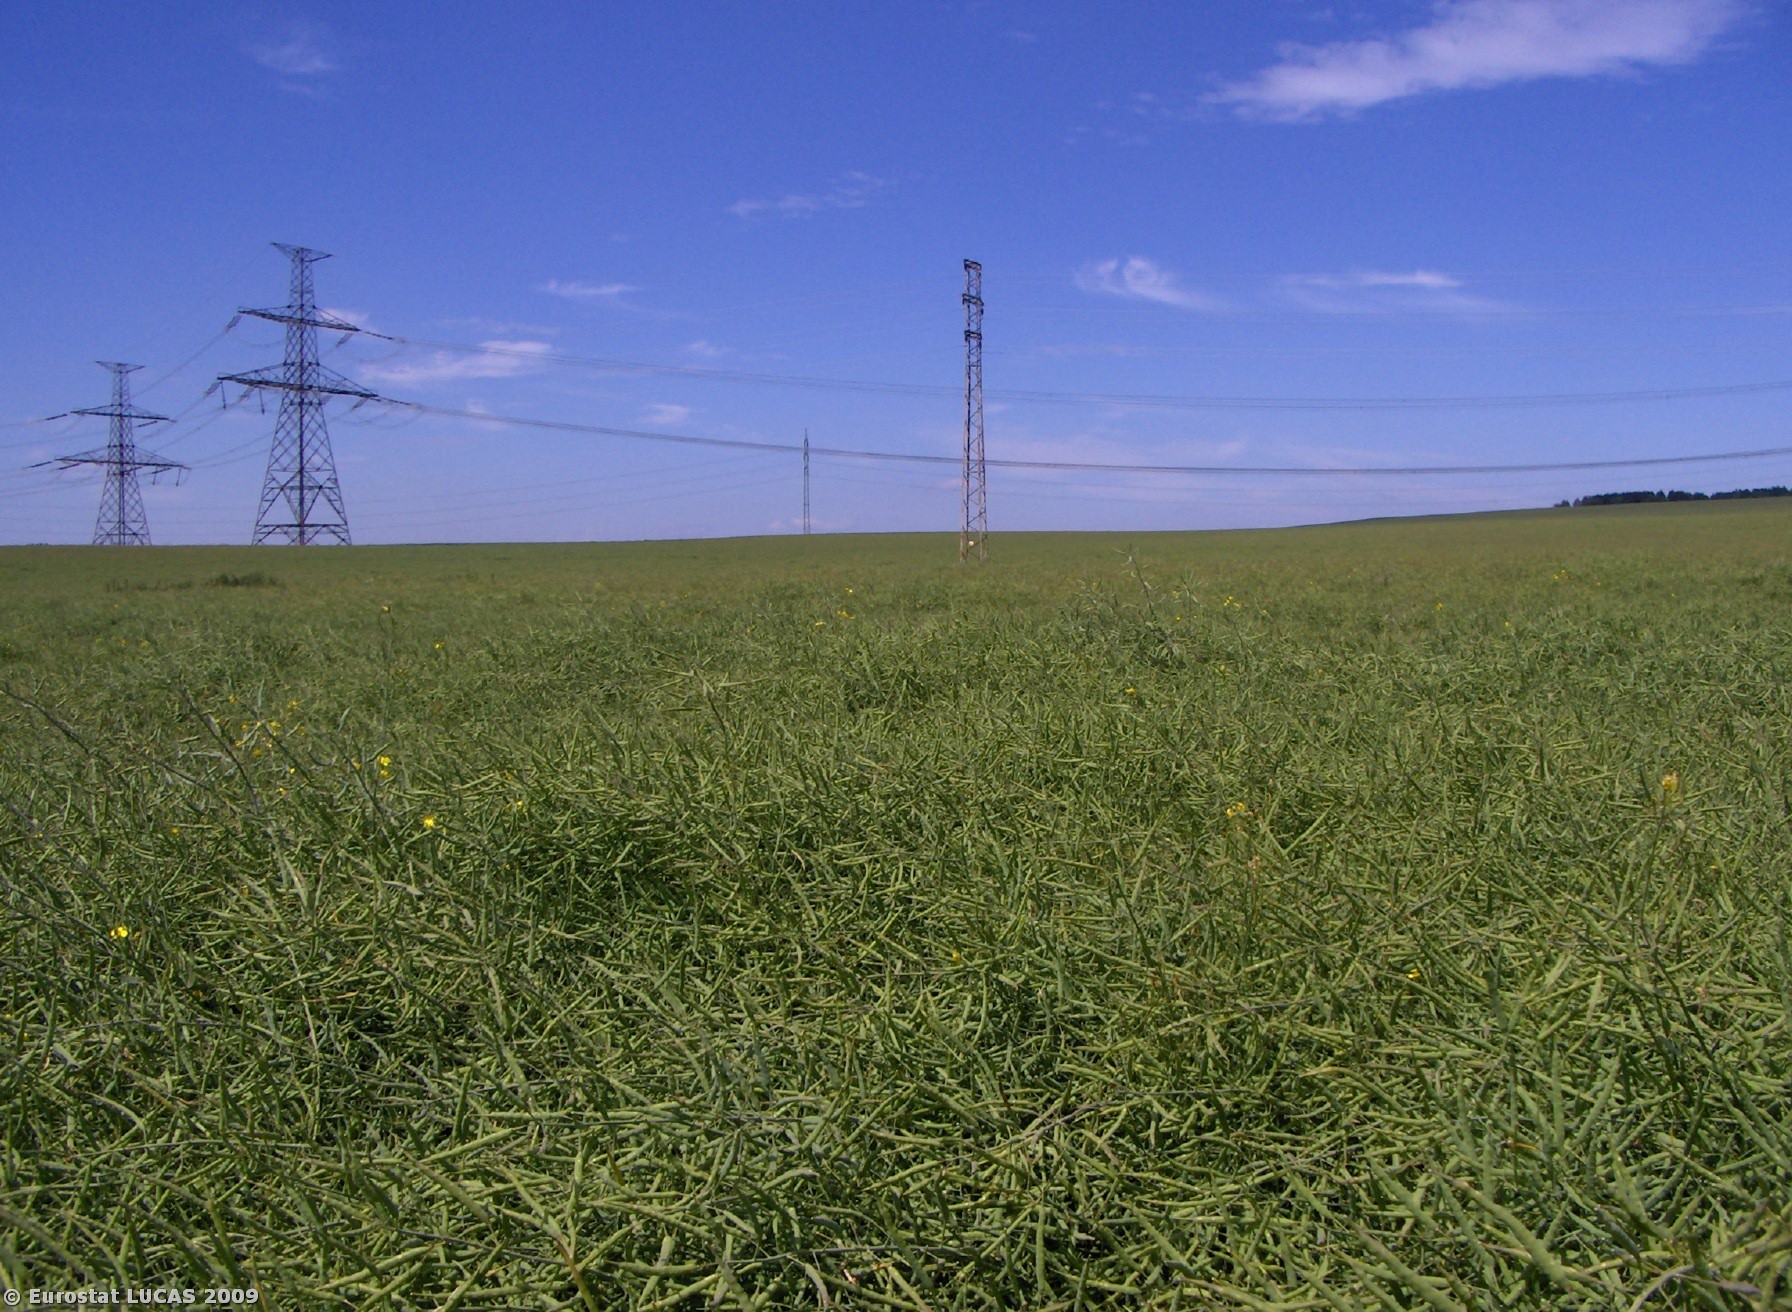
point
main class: Cropland
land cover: Rape and turnip rape
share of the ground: > 75 %
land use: Agriculture (excluding fallow land and kitchen gardens)
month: June
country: CZ
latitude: 49.5352
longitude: 14.0771
